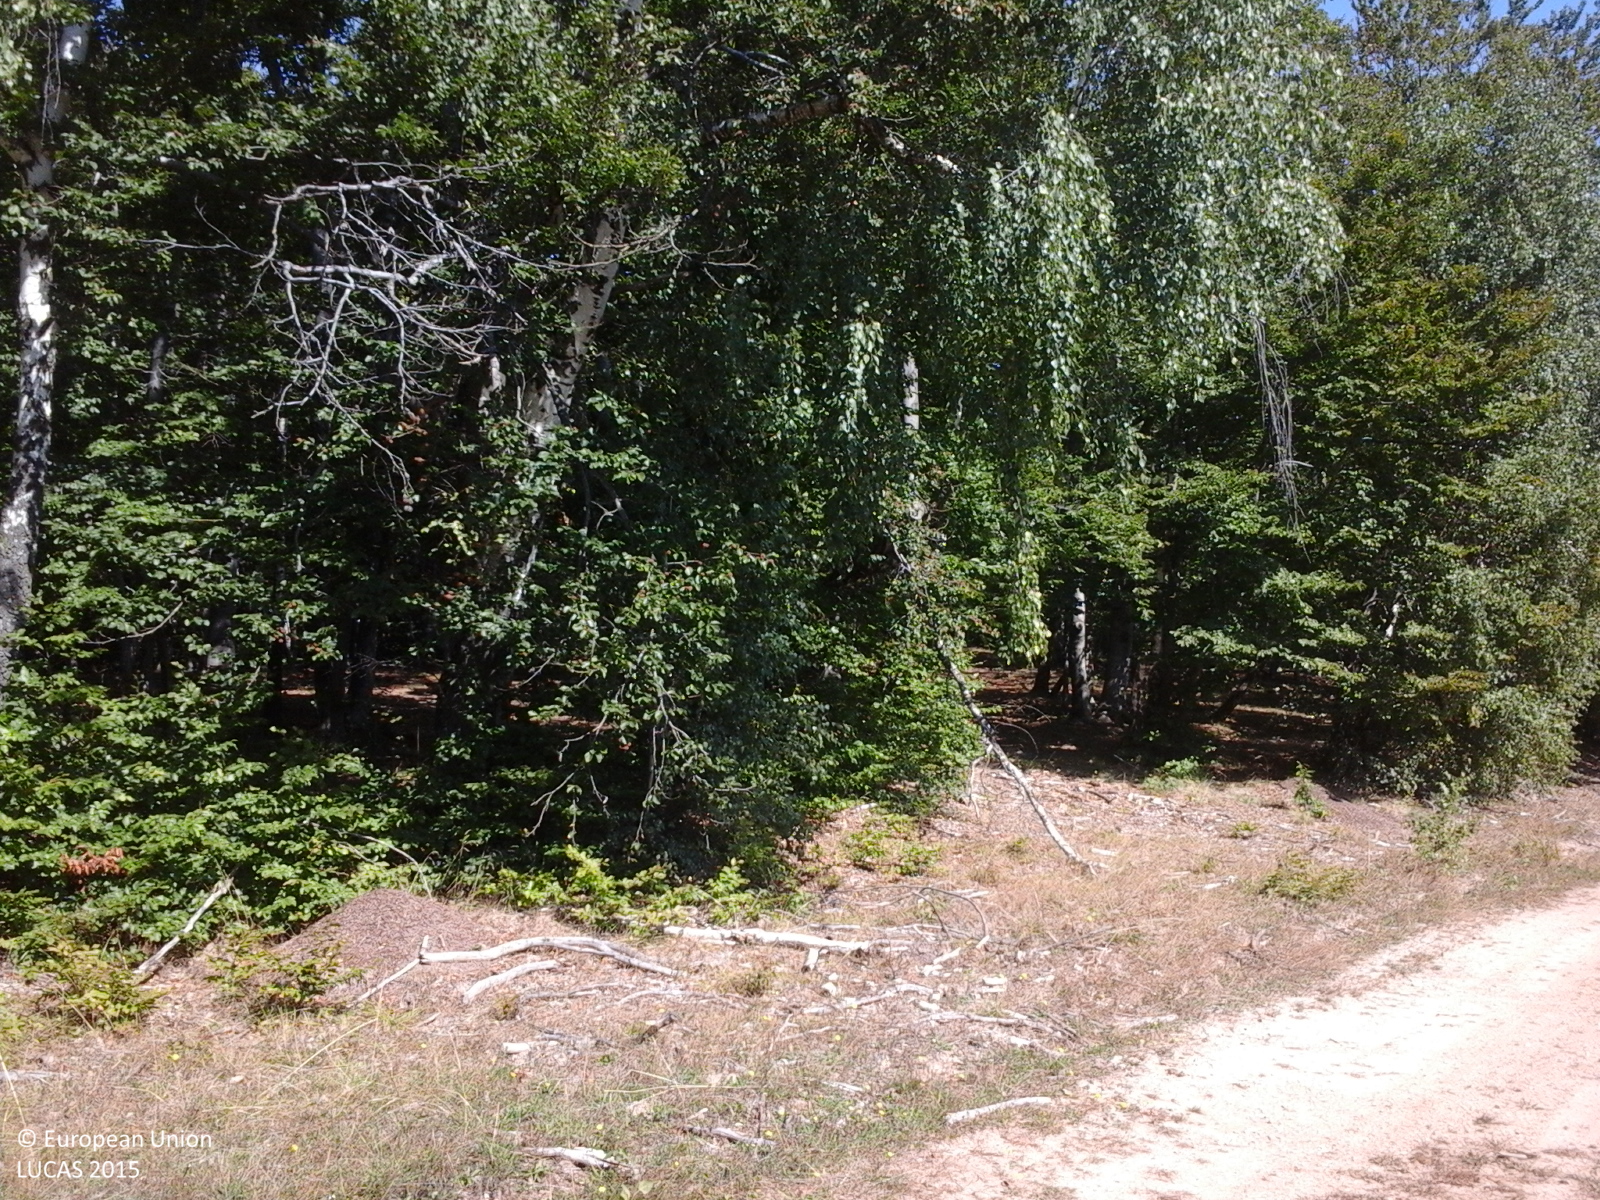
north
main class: Woodland
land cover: Broadleaved woodland
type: broadleaved evergreen forest
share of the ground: > 75 %
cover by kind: broadleaved forest trees 100 %
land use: Forestry
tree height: > 5 m
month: September
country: RO
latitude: 47.1665
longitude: 22.4685
